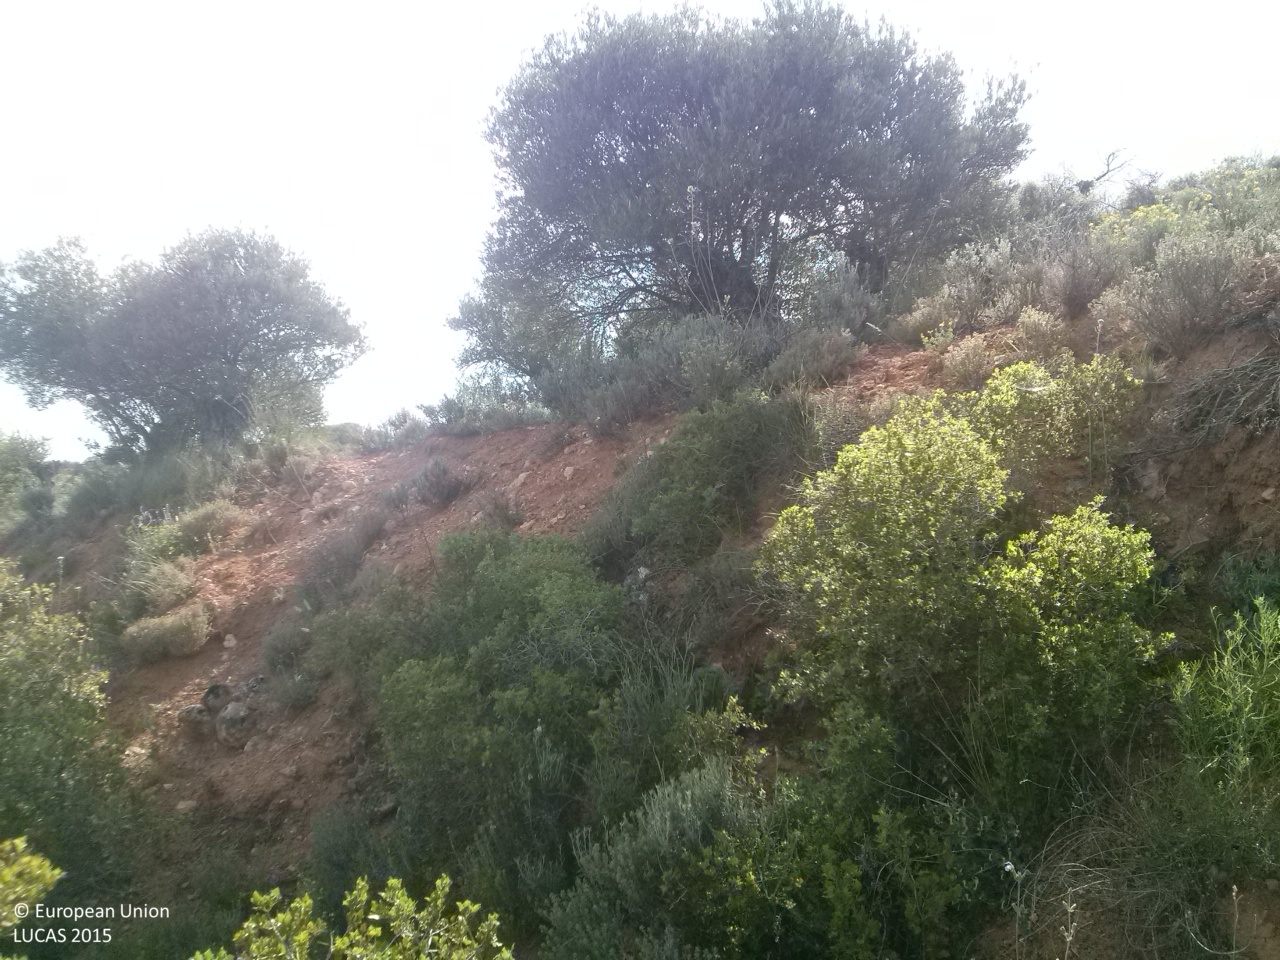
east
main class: Cropland
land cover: Olive groves
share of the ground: 10 - 25 %
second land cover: Shrubland without tree cover
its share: 50 - 75 %
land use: Abandoned areas
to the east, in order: Olive groves; Shrubland without tree cover; Shrubland with sparse tree cover; Abandoned hedges; Olive groves; Abandoned hedges; Olive groves; Abandoned hedges; Olive groves; Abandoned hedges; Shrubland with sparse tree cover; Abandoned hedges; Dry stone walls; Shrubland with sparse tree cover
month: May
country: ES
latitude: 40.1613
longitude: -2.9044
